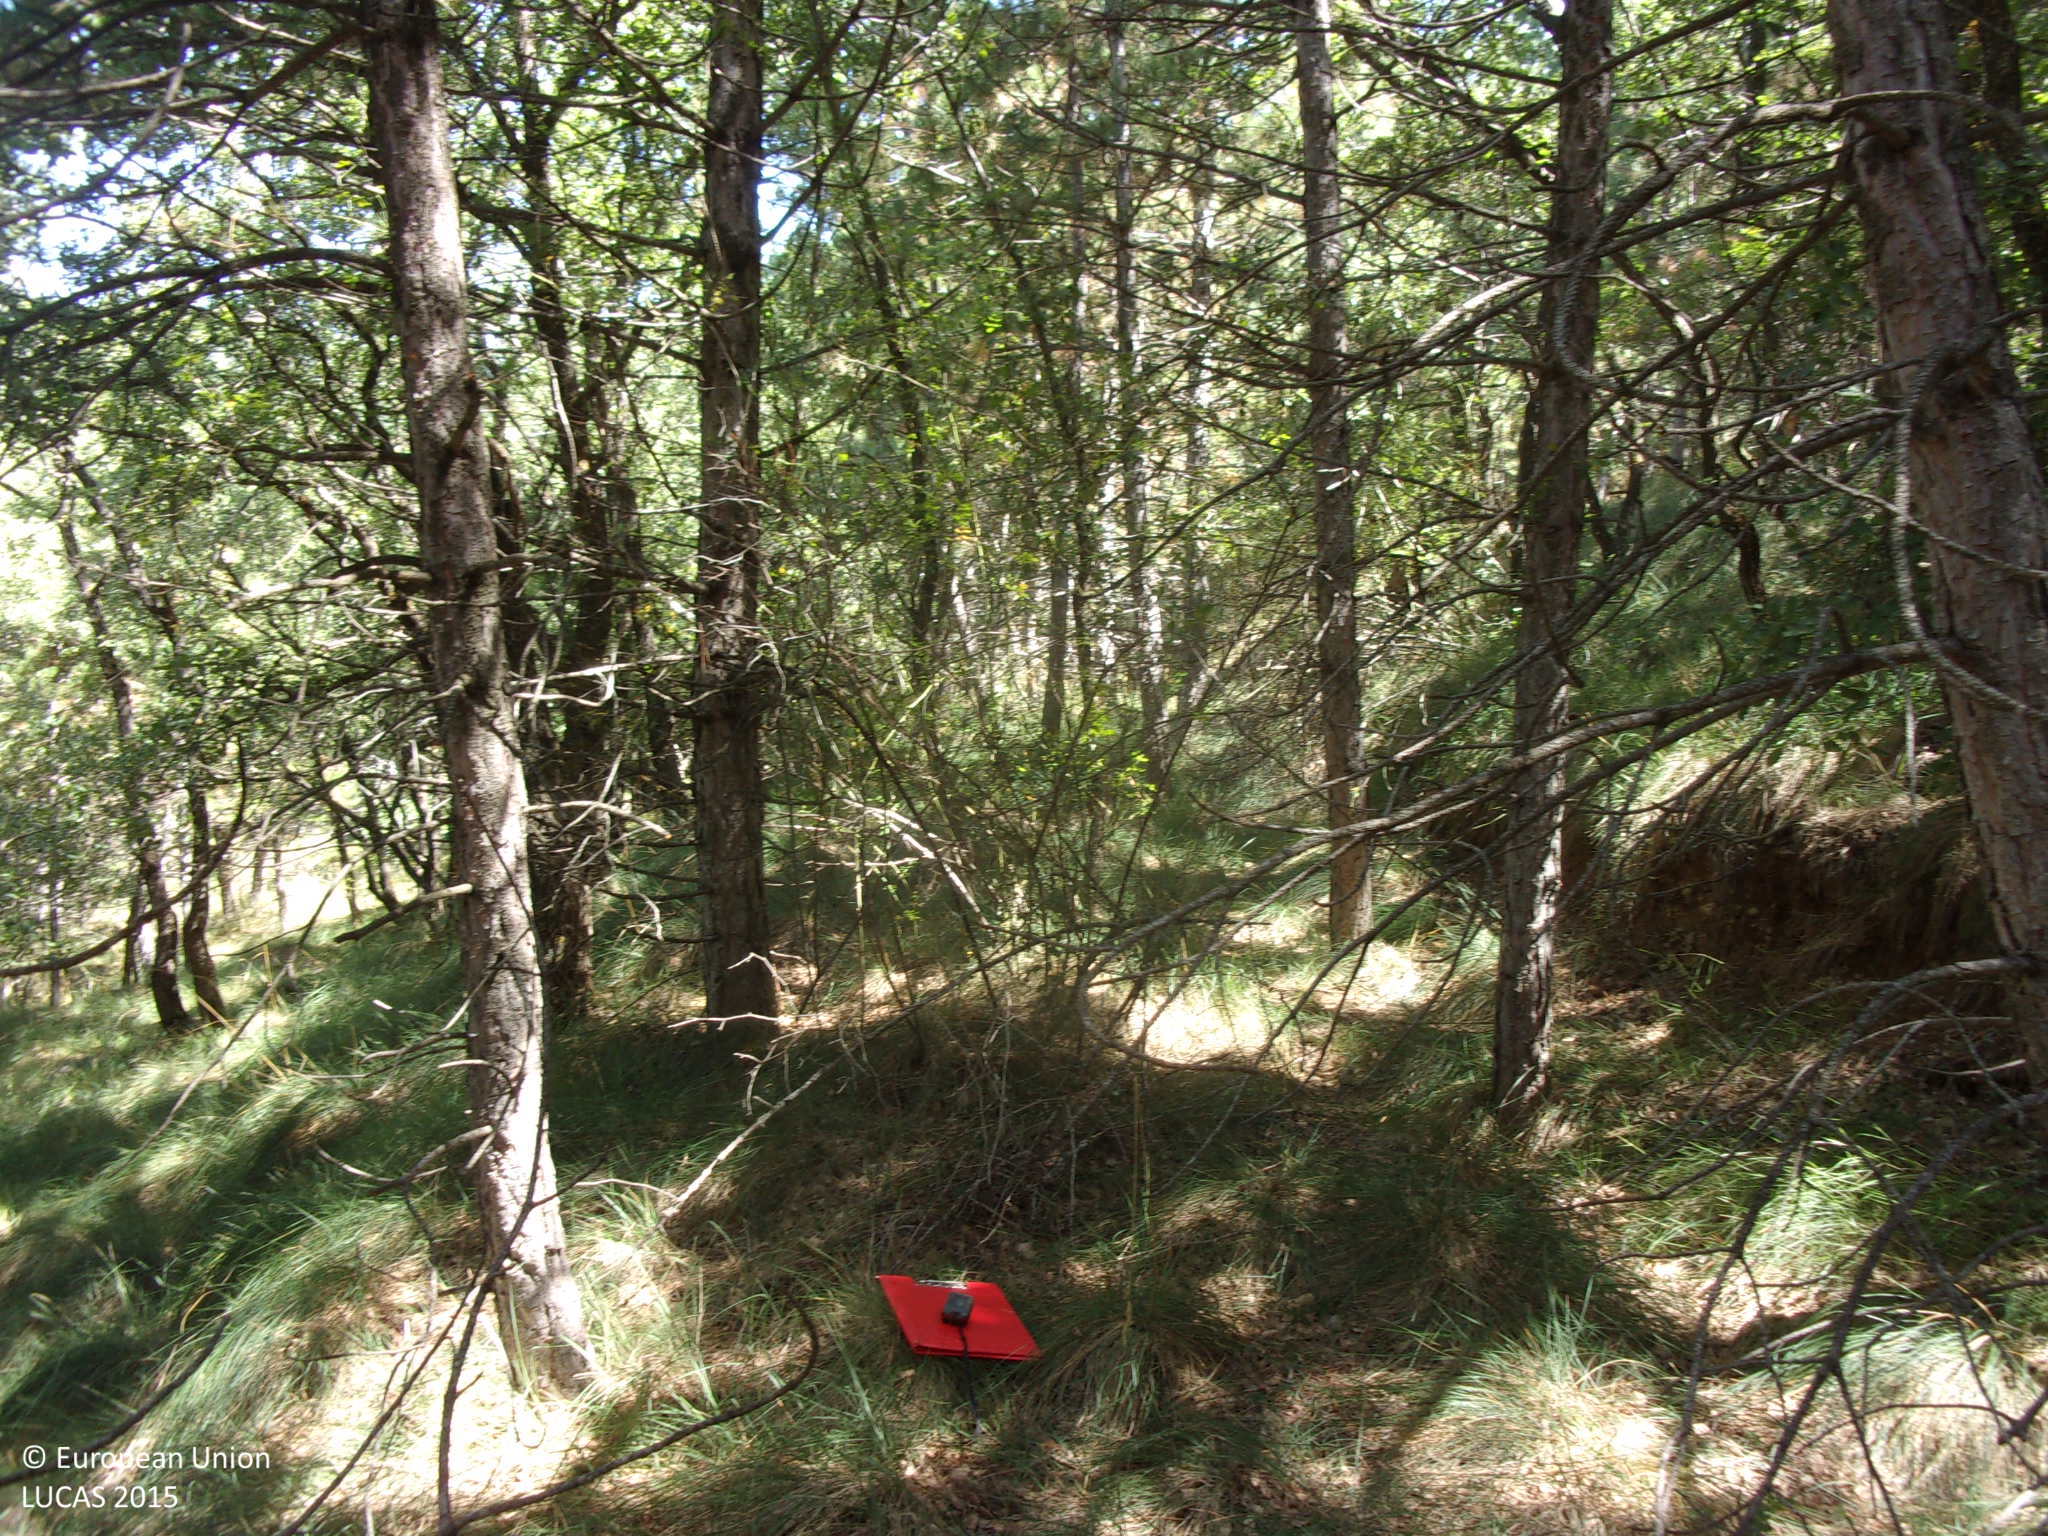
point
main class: Woodland
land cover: Pine dominated coniferous woodland
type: coniferous forest of the mediterranean region
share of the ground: > 75 %
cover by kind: coniferous forest trees 100 %
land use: Forestry
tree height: > 5 m
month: August
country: ES
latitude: 42.4518
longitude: -1.1814
